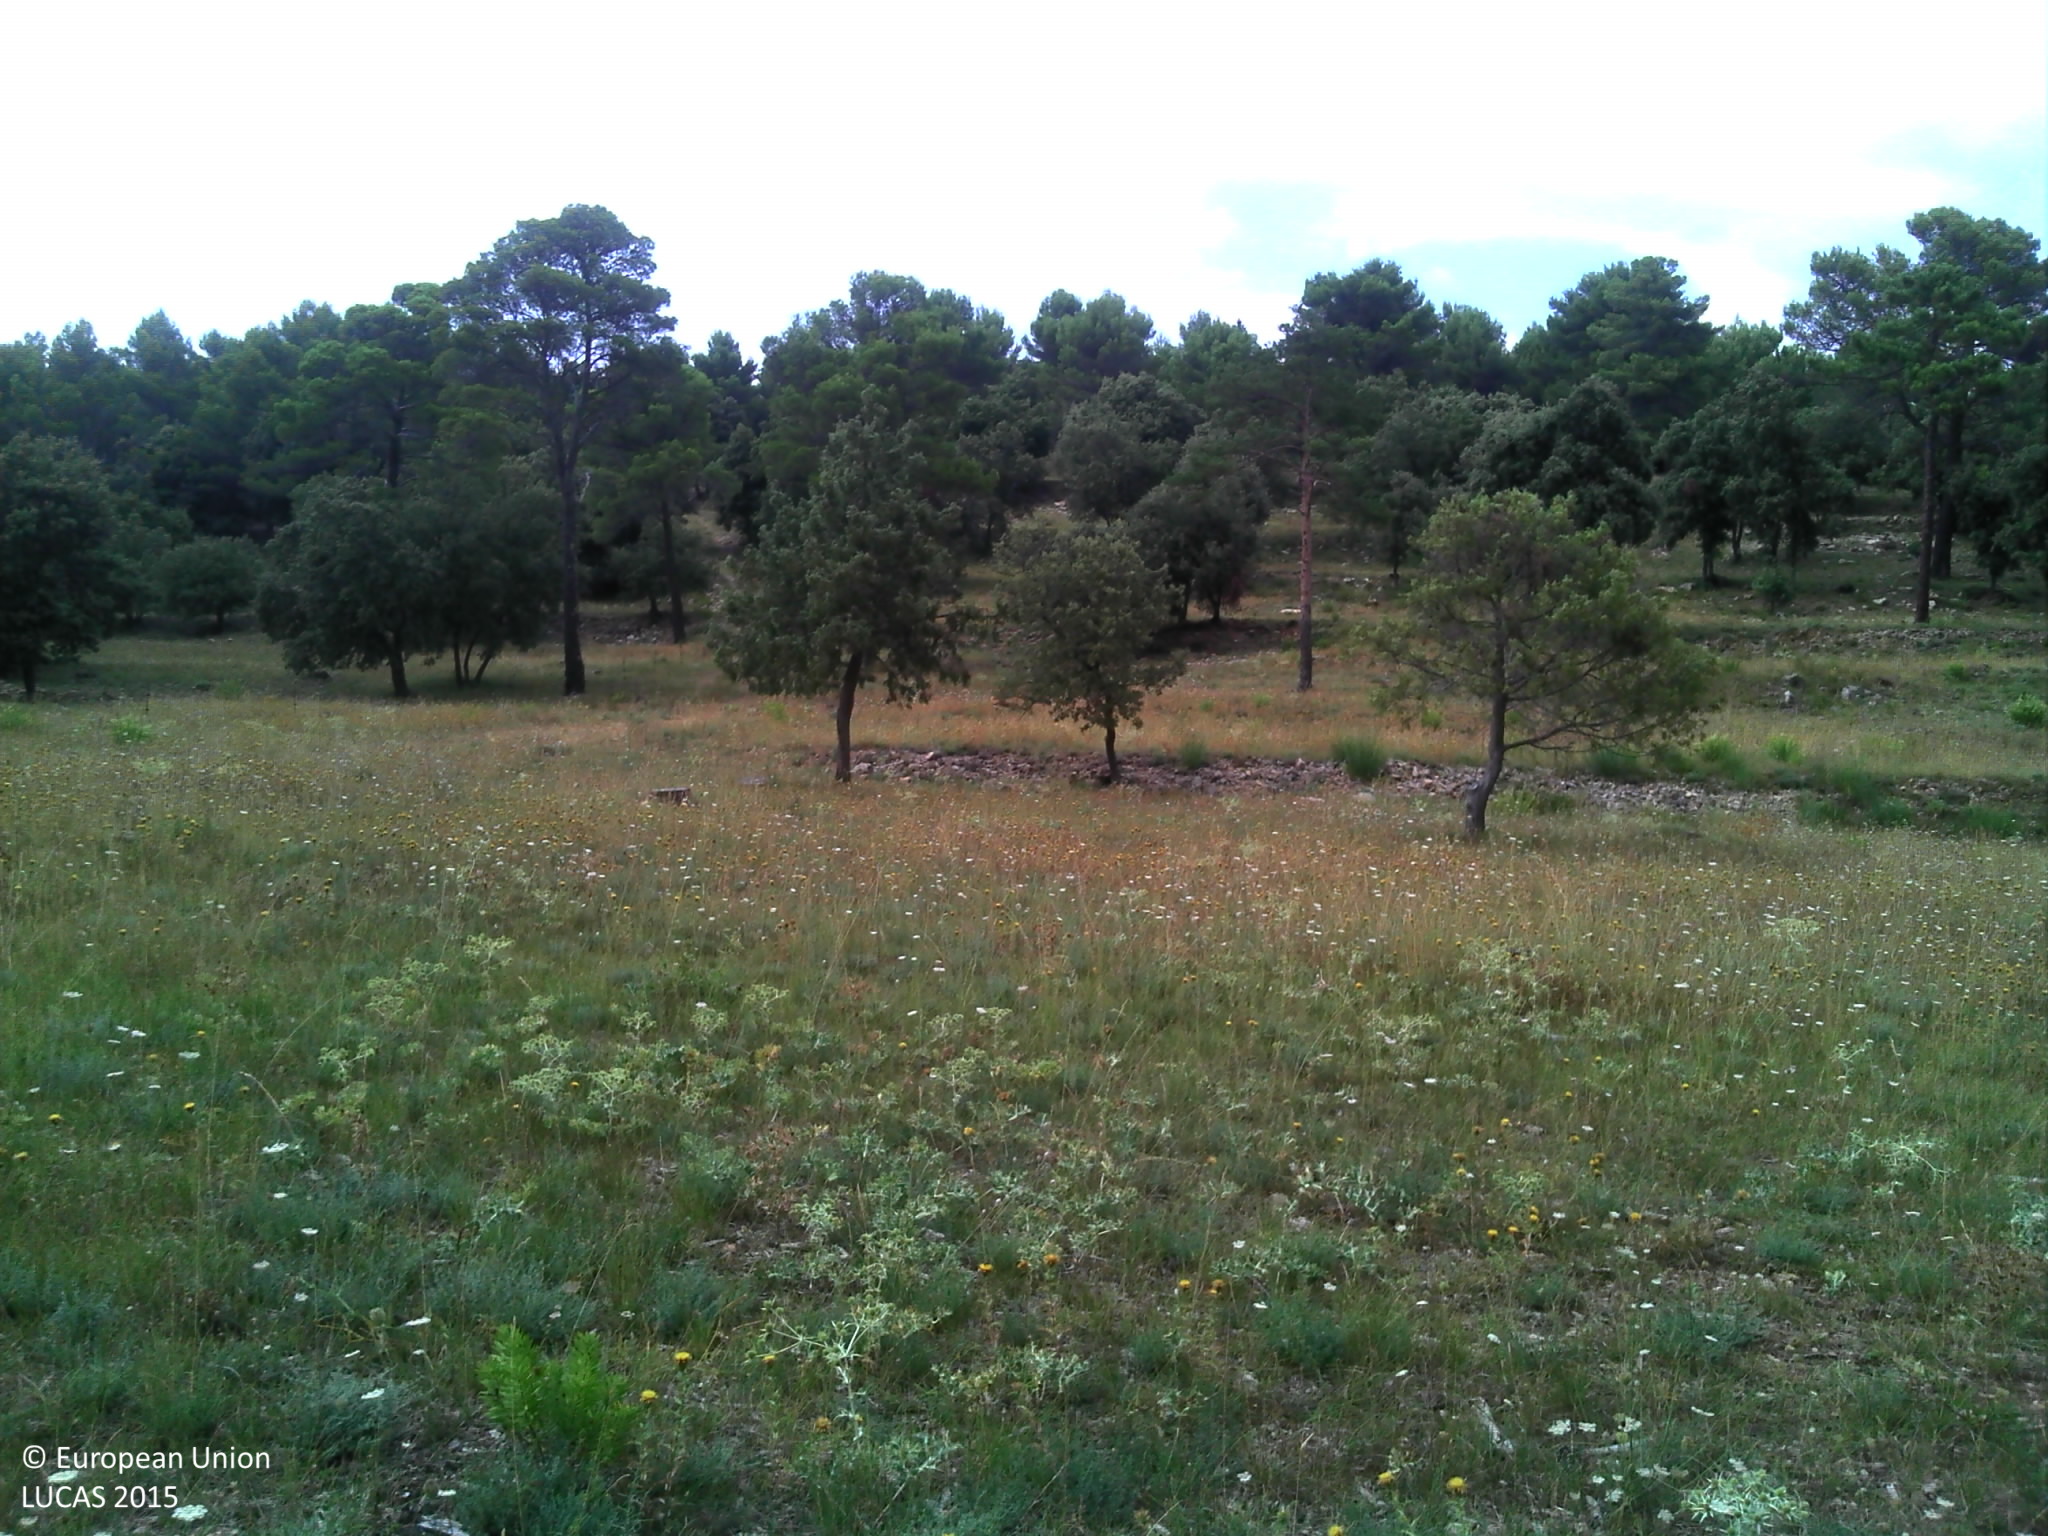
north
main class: Grassland
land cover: Grassland with sparse tree/shrub cover
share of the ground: > 75 %
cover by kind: herbaceous plants 95 %, coniferous forest trees 5 %
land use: Amenities, museums, leisure
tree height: > 5 m
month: August
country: FR
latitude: 43.5814
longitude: 6.3305
